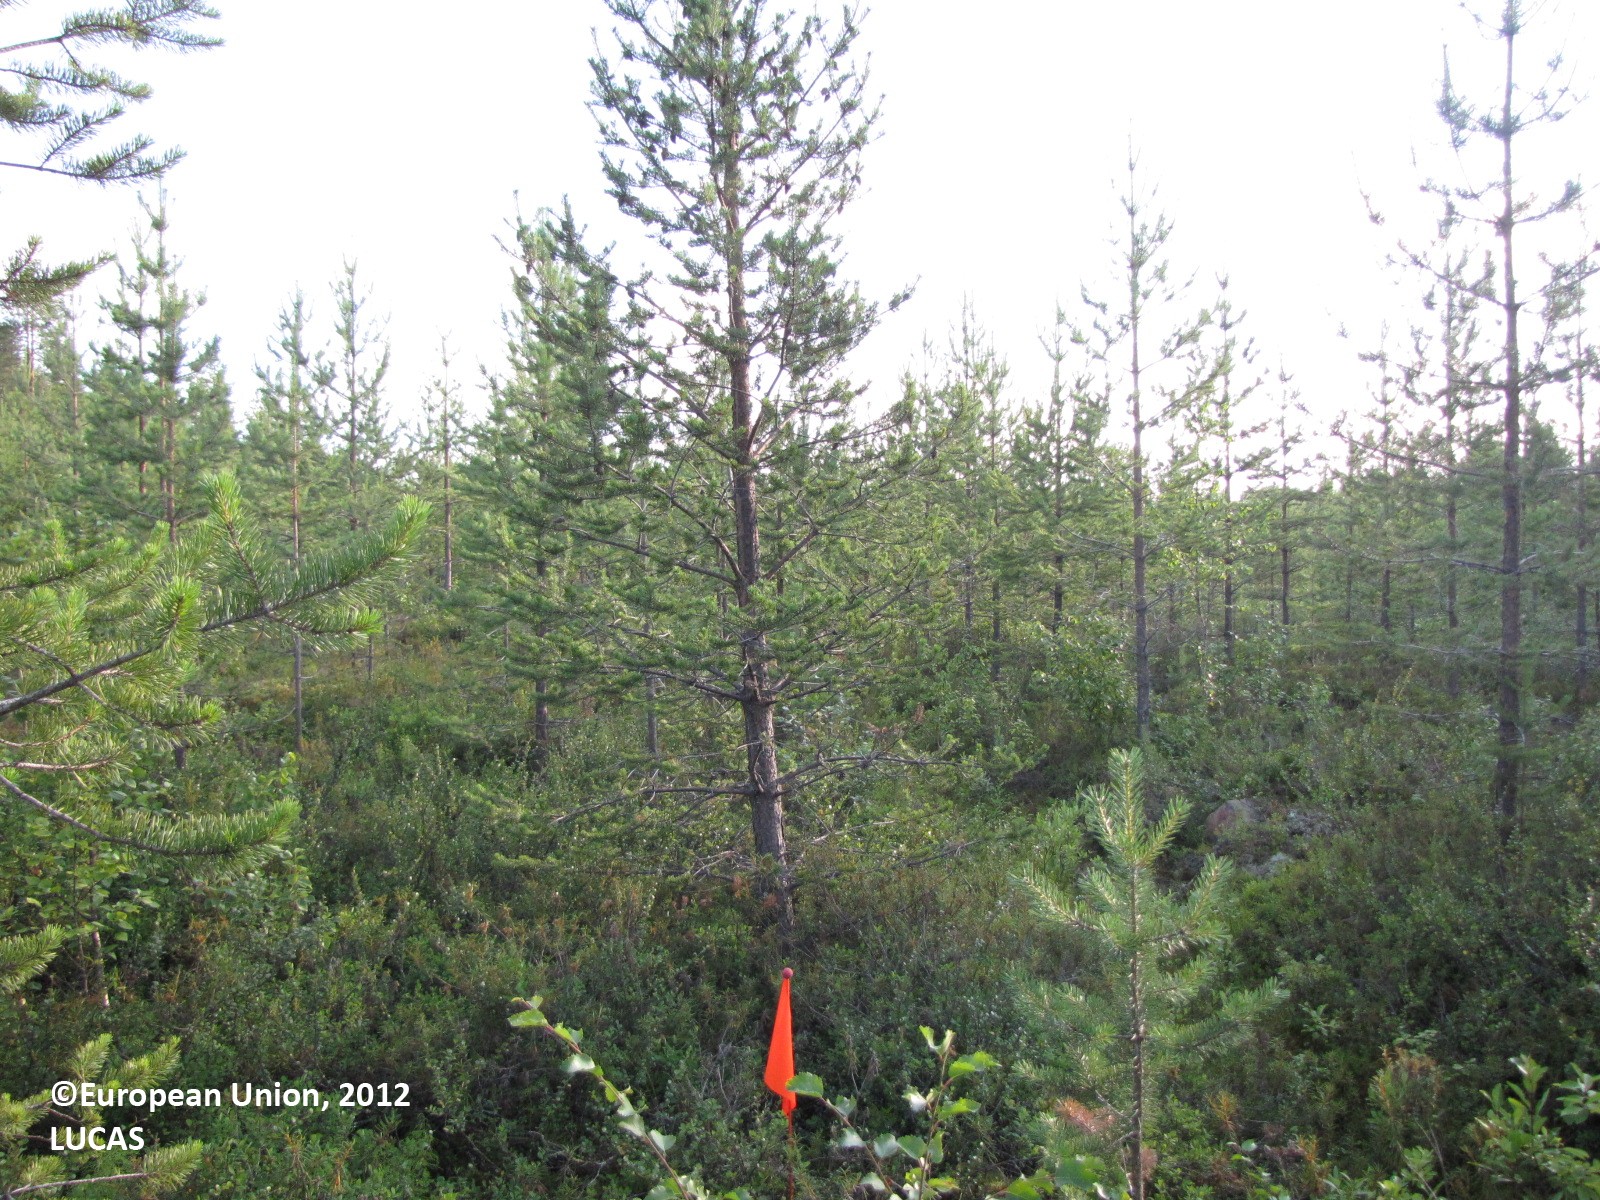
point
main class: Woodland
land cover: Pine dominated coniferous woodland
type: boreal forest
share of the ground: 50 - 75 %
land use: Forestry
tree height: < 5 m
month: July
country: FI
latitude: 66.7013
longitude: 24.4740
